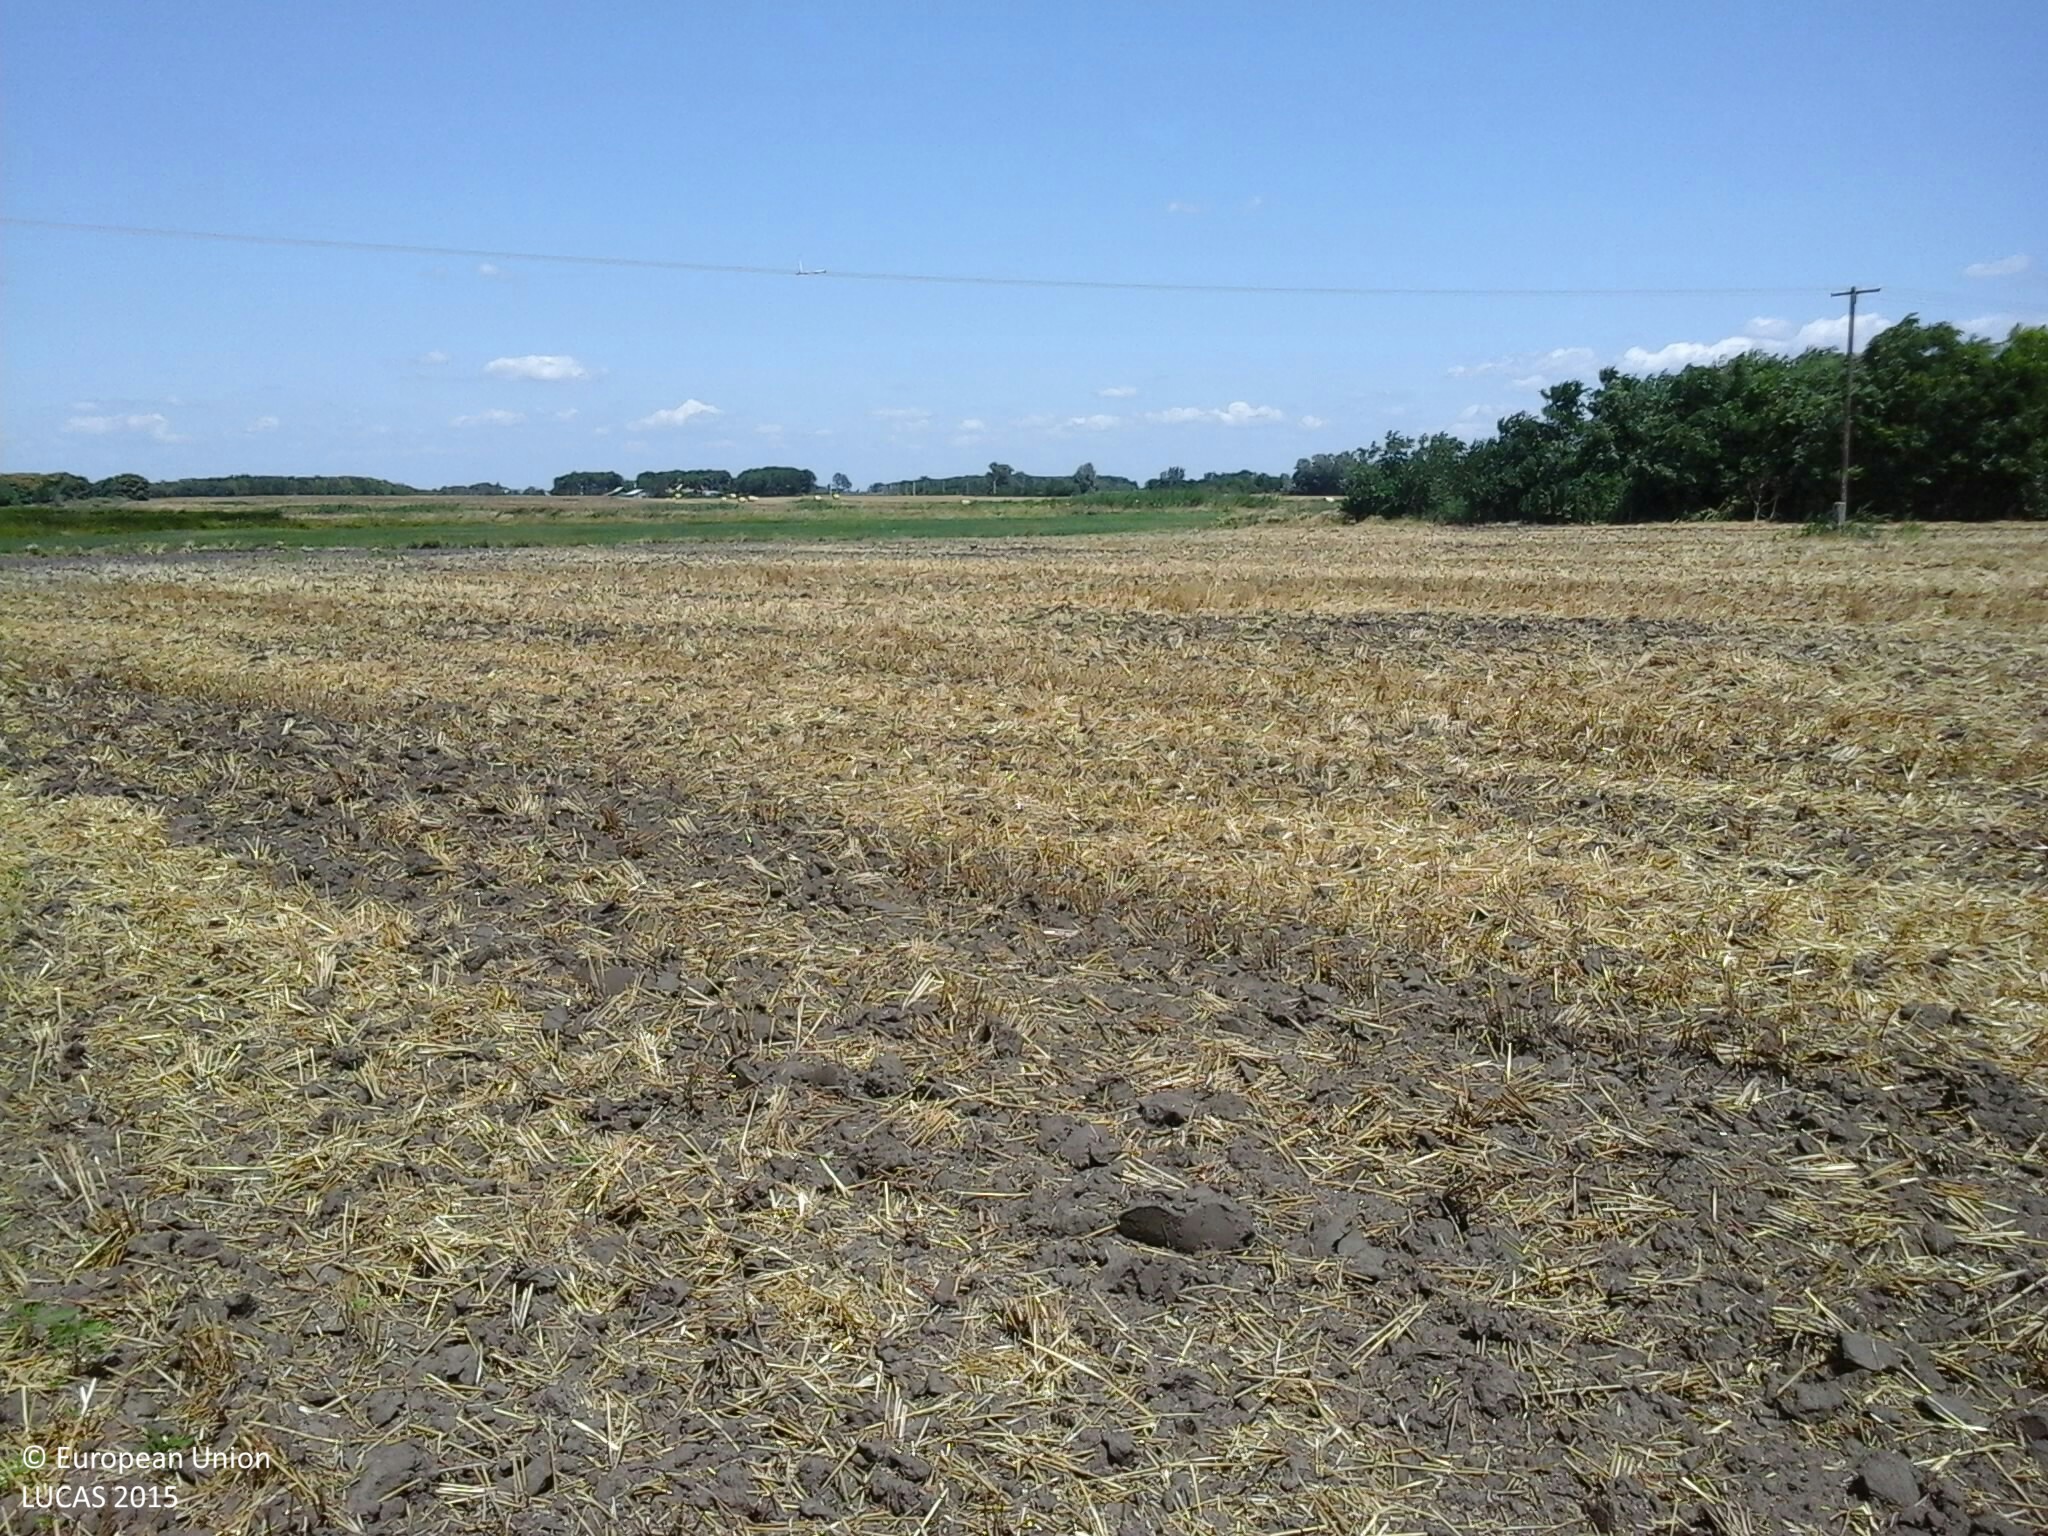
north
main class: Cropland
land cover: Common wheat
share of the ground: < 10 %
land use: Agriculture (excluding fallow land and kitchen gardens)
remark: Harvested field
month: July
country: HU
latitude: 46.6370
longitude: 20.0684
